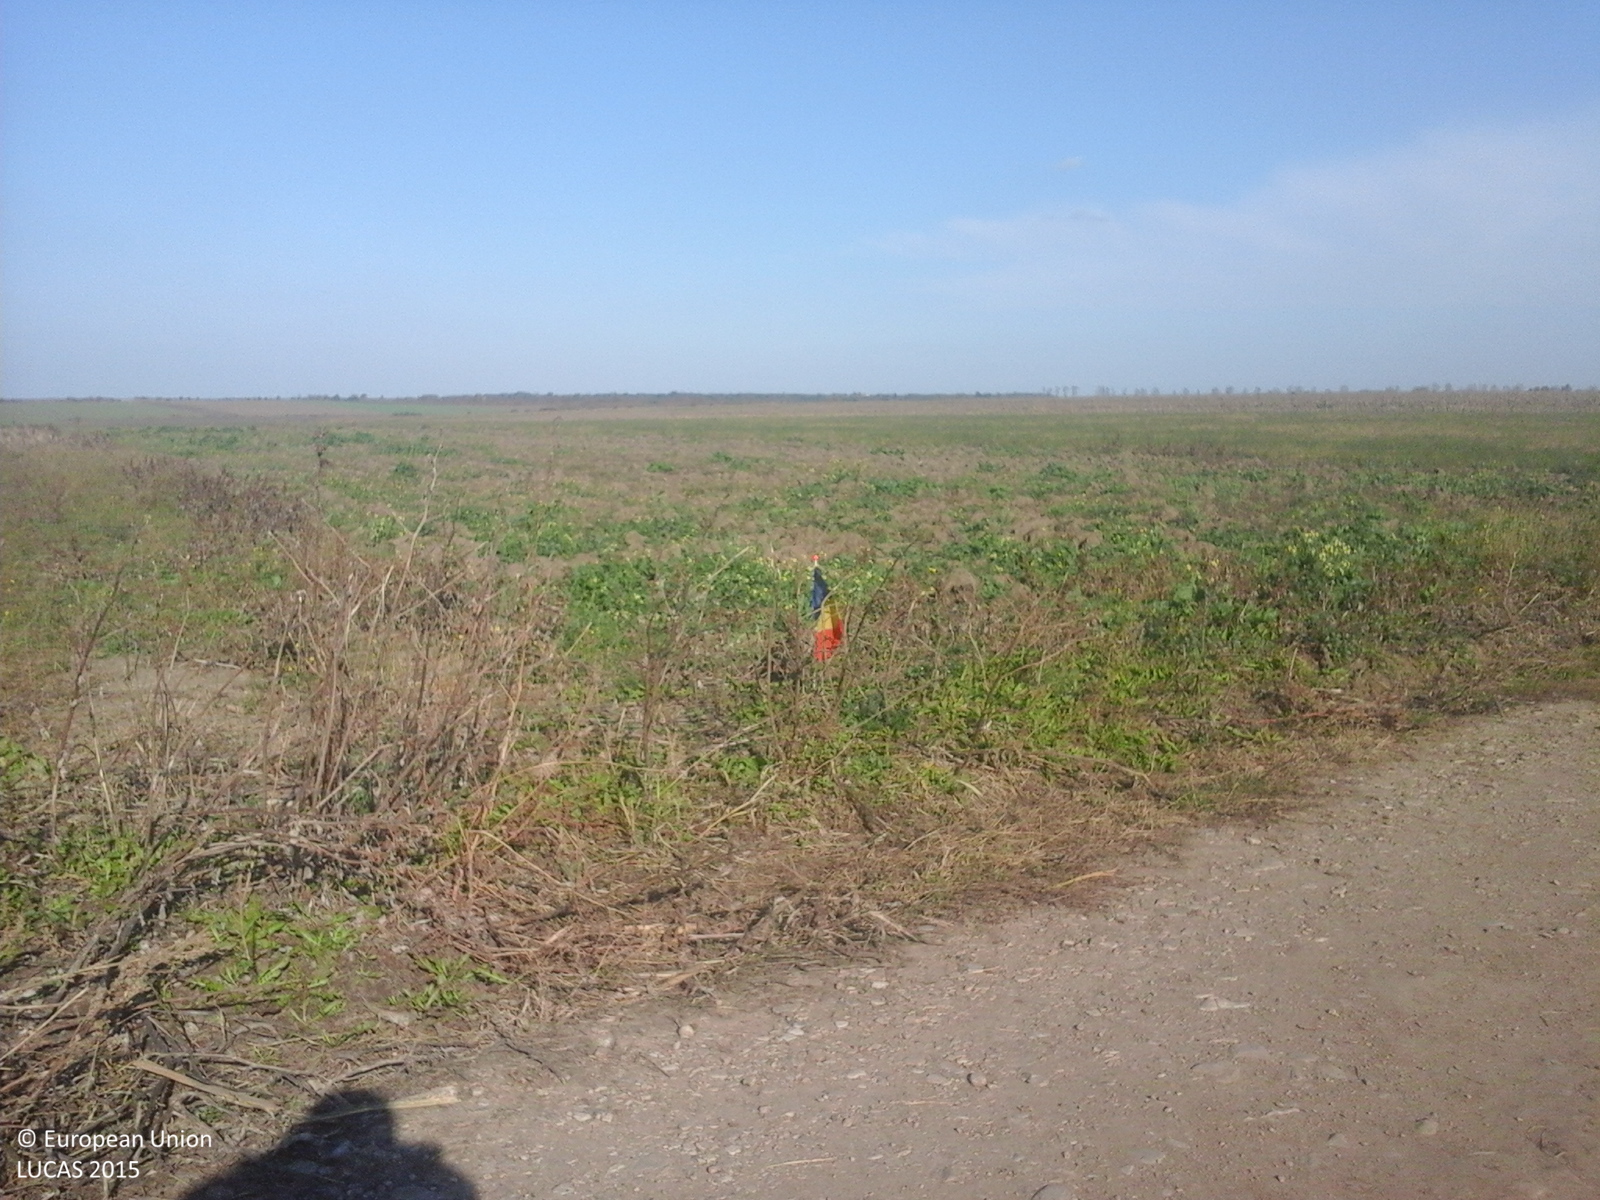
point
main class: Grassland
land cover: Spontaneously vegetated surfaces
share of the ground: > 75 %
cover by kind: herbaceous plants 100 %
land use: Fallow land
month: October
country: RO
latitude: 45.2489
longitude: 27.3602
